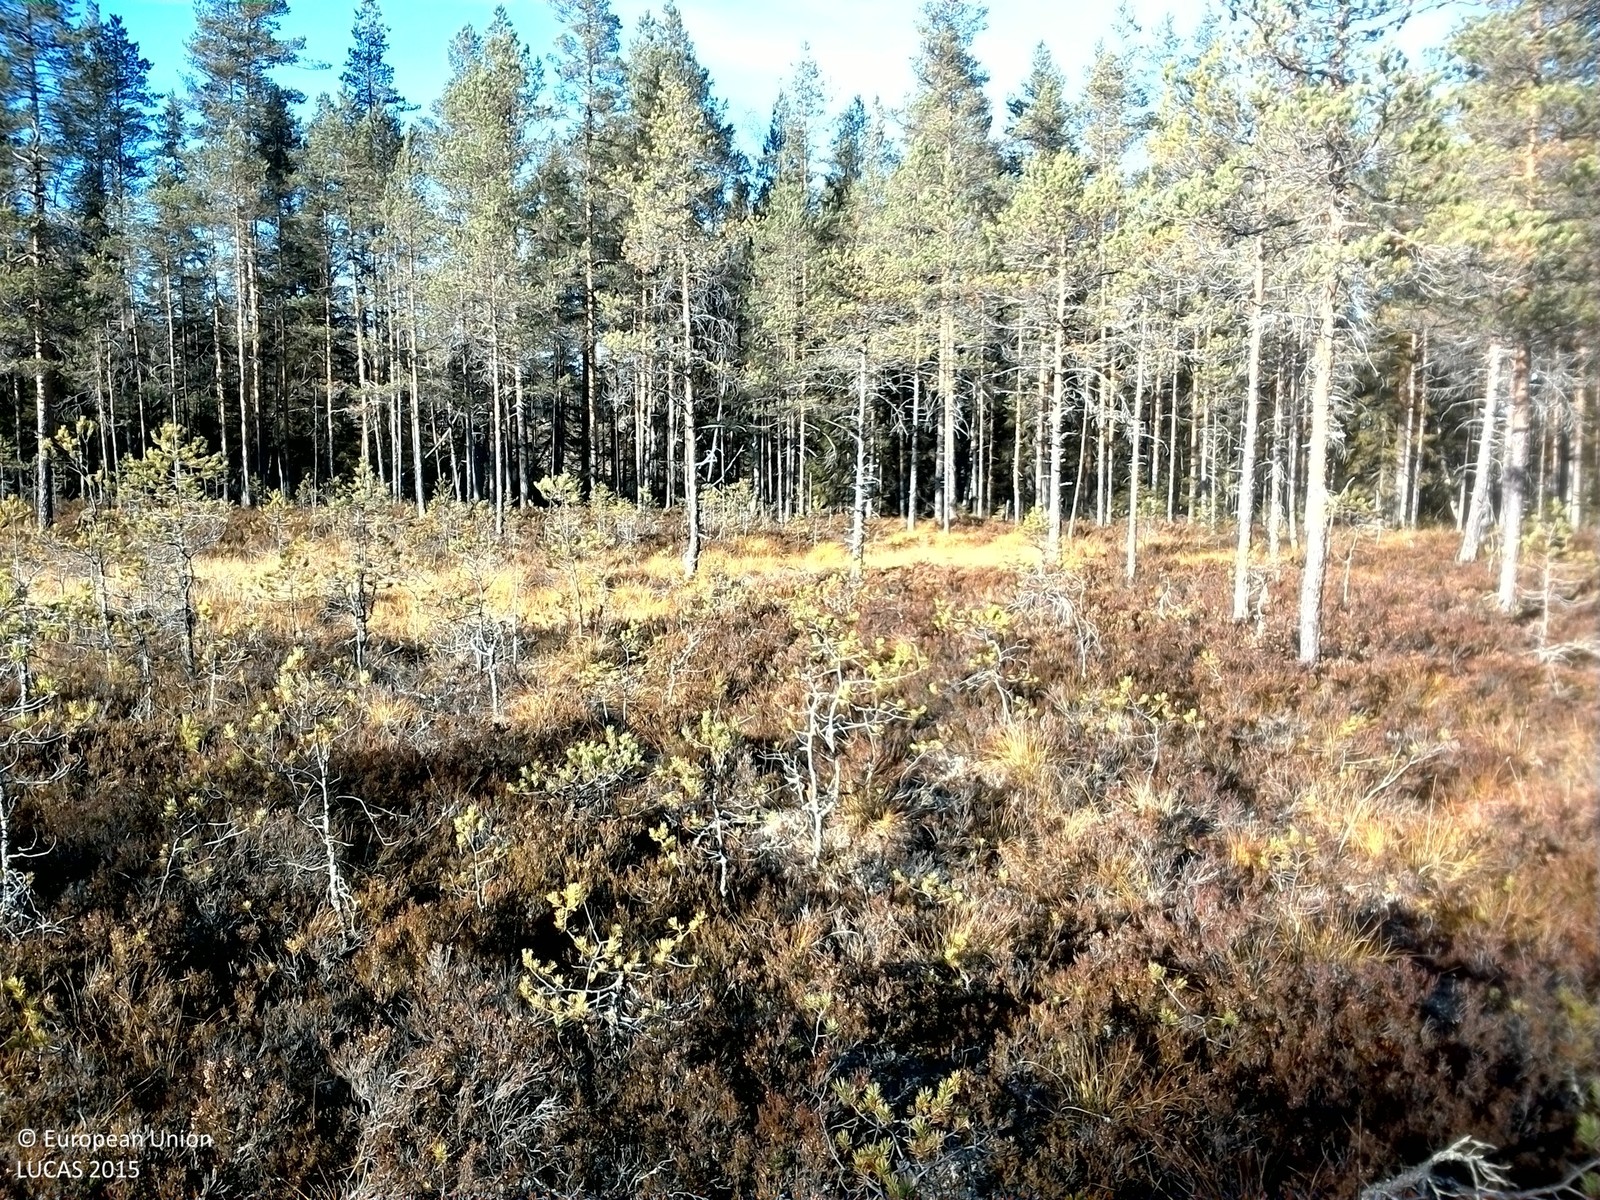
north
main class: Woodland
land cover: Pine dominated coniferous woodland
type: boreal forest
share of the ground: 10 - 25 %
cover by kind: lichens and mosses 40 %, shrubs 25 %, coniferous forest trees 20 %, herbaceous plants 15 %
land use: Semi-natural and natural areas not in use
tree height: < 5 m
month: October
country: SE
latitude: 61.1776
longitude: 14.3561
